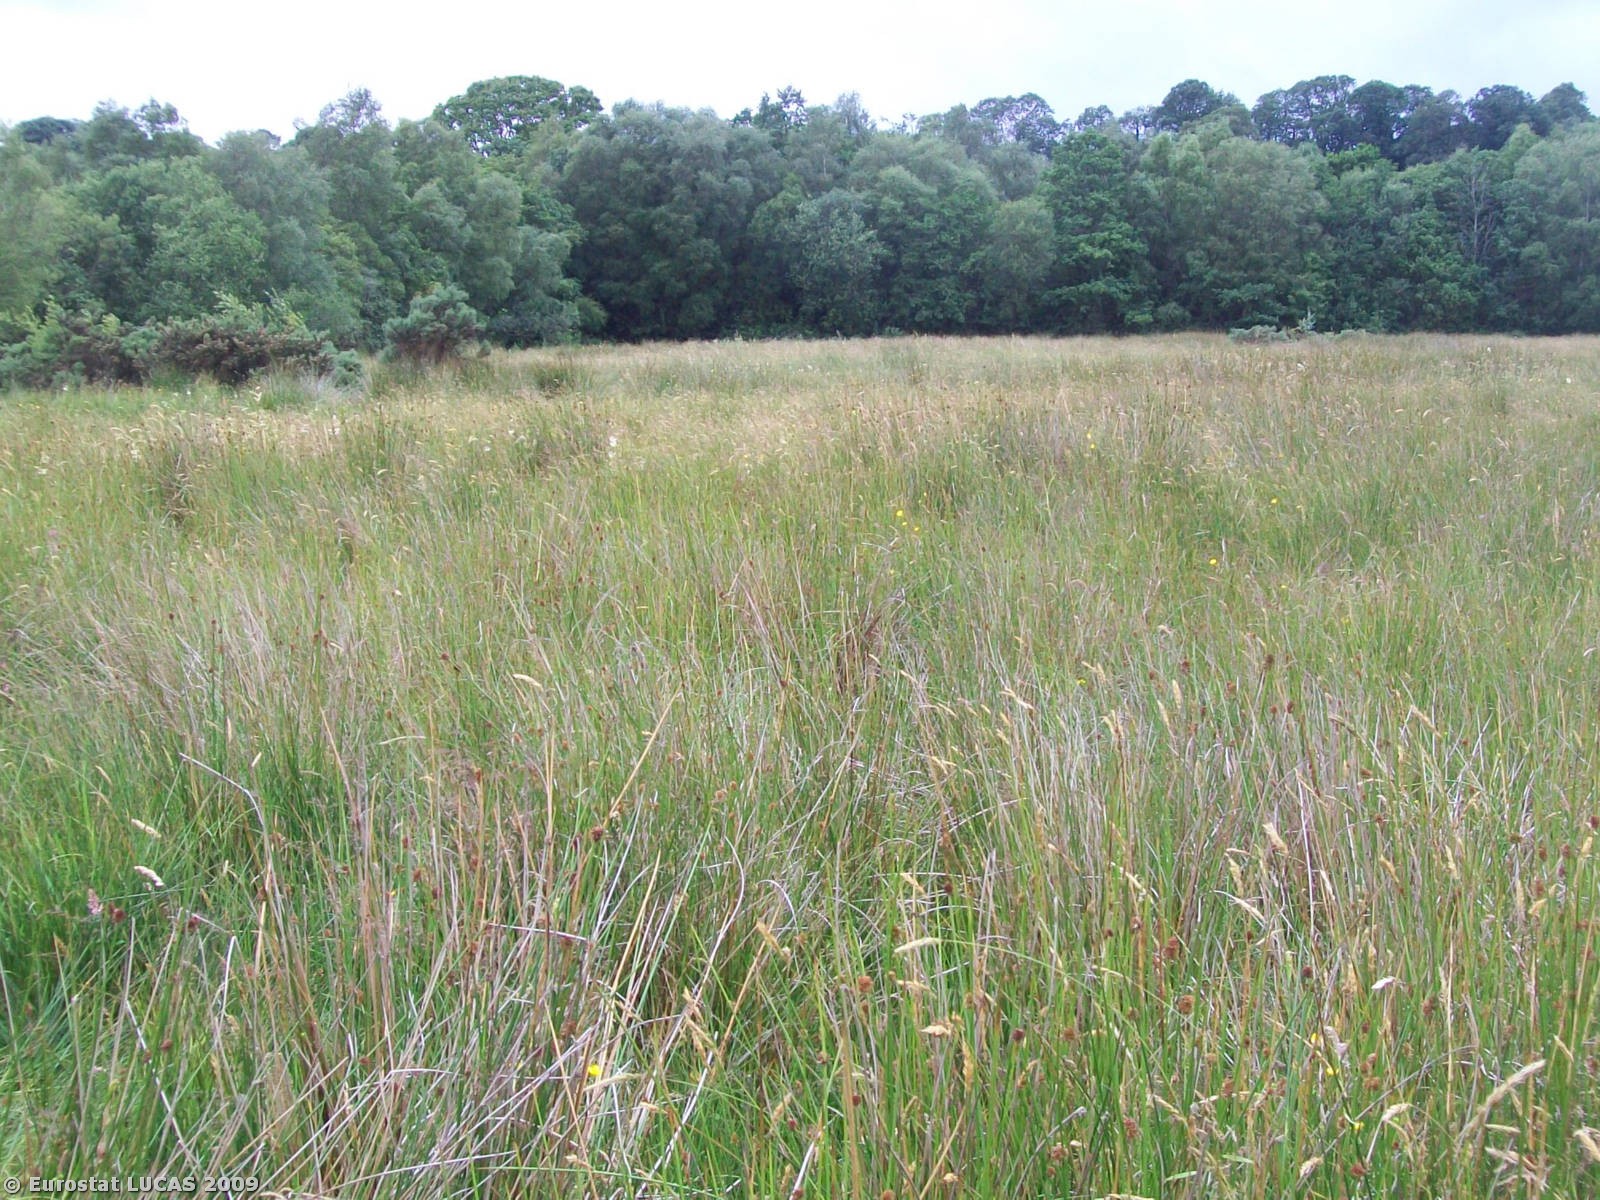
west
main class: Woodland
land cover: Broadleaved woodland
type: mesophytic deciduous forest
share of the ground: > 75 %
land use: Forestry
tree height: > 5 m
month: July
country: GB
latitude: 54.7840
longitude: -6.7213
